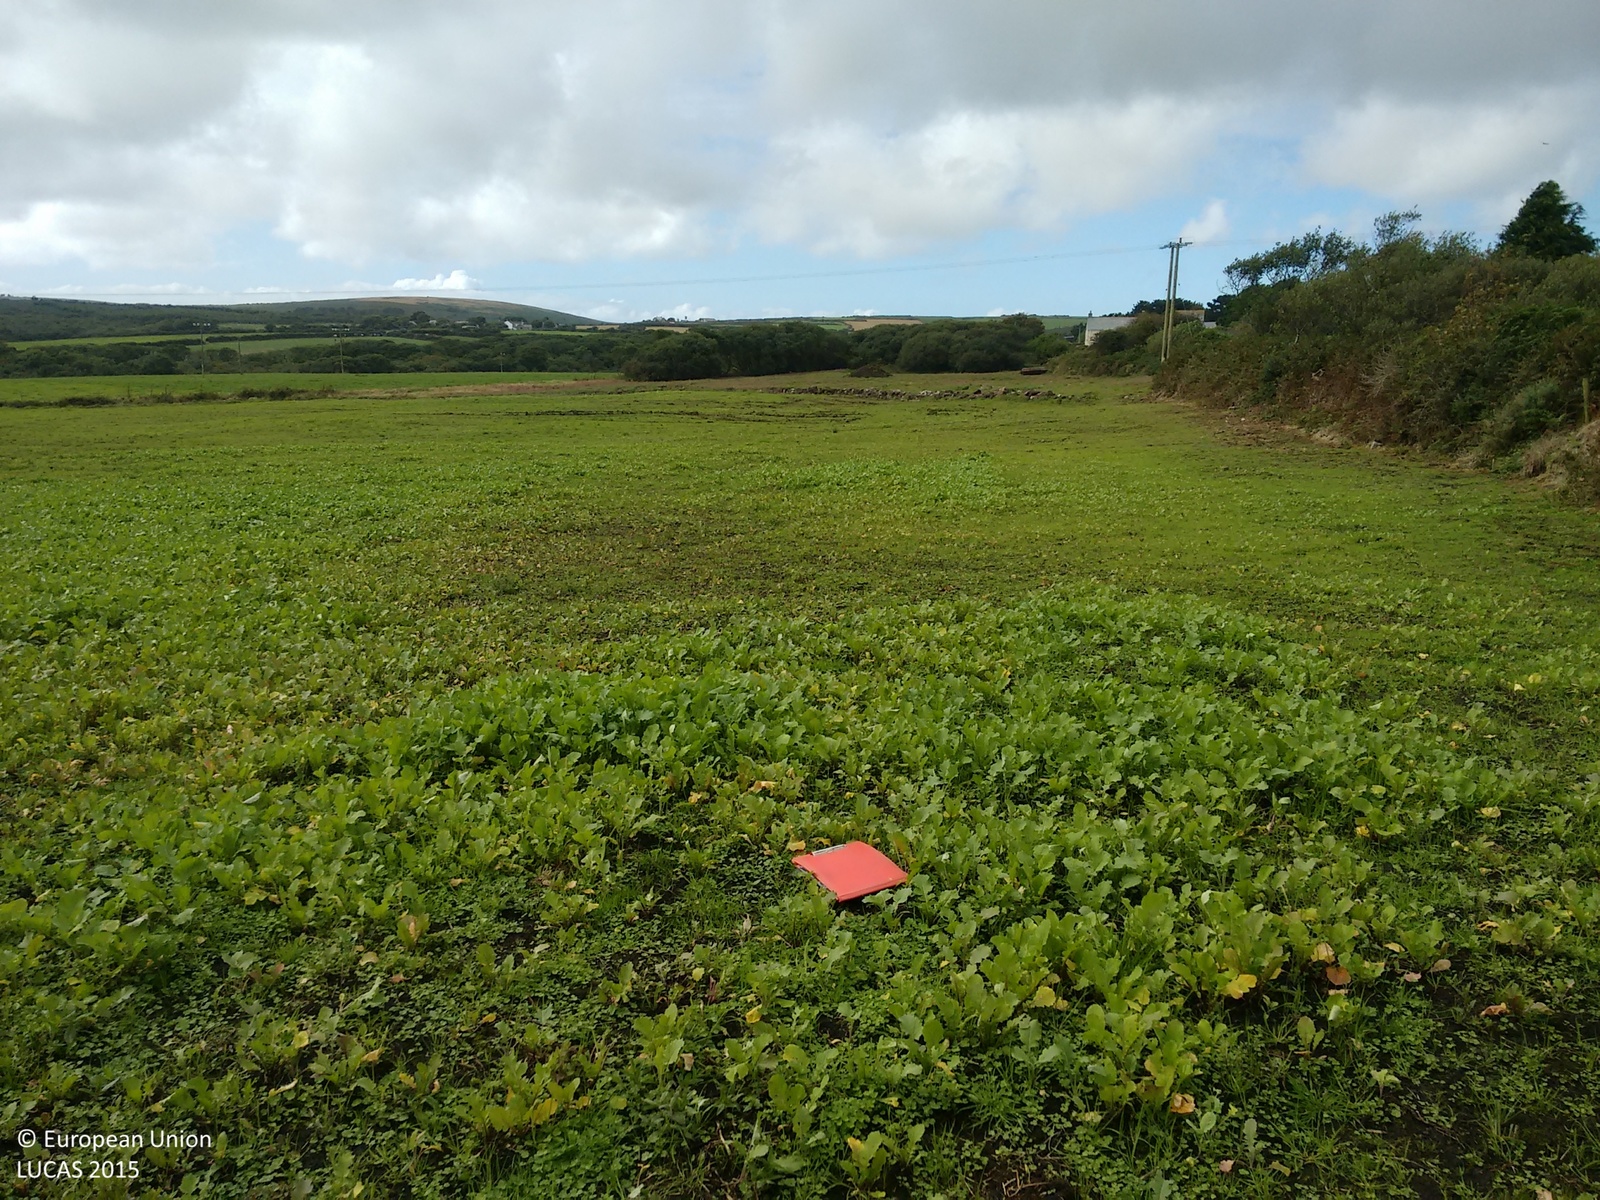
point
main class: Cropland
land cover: Other root crops
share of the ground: > 75 %
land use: Agriculture (excluding fallow land and kitchen gardens)
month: August
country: GB
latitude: 50.1544
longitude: -5.5383
